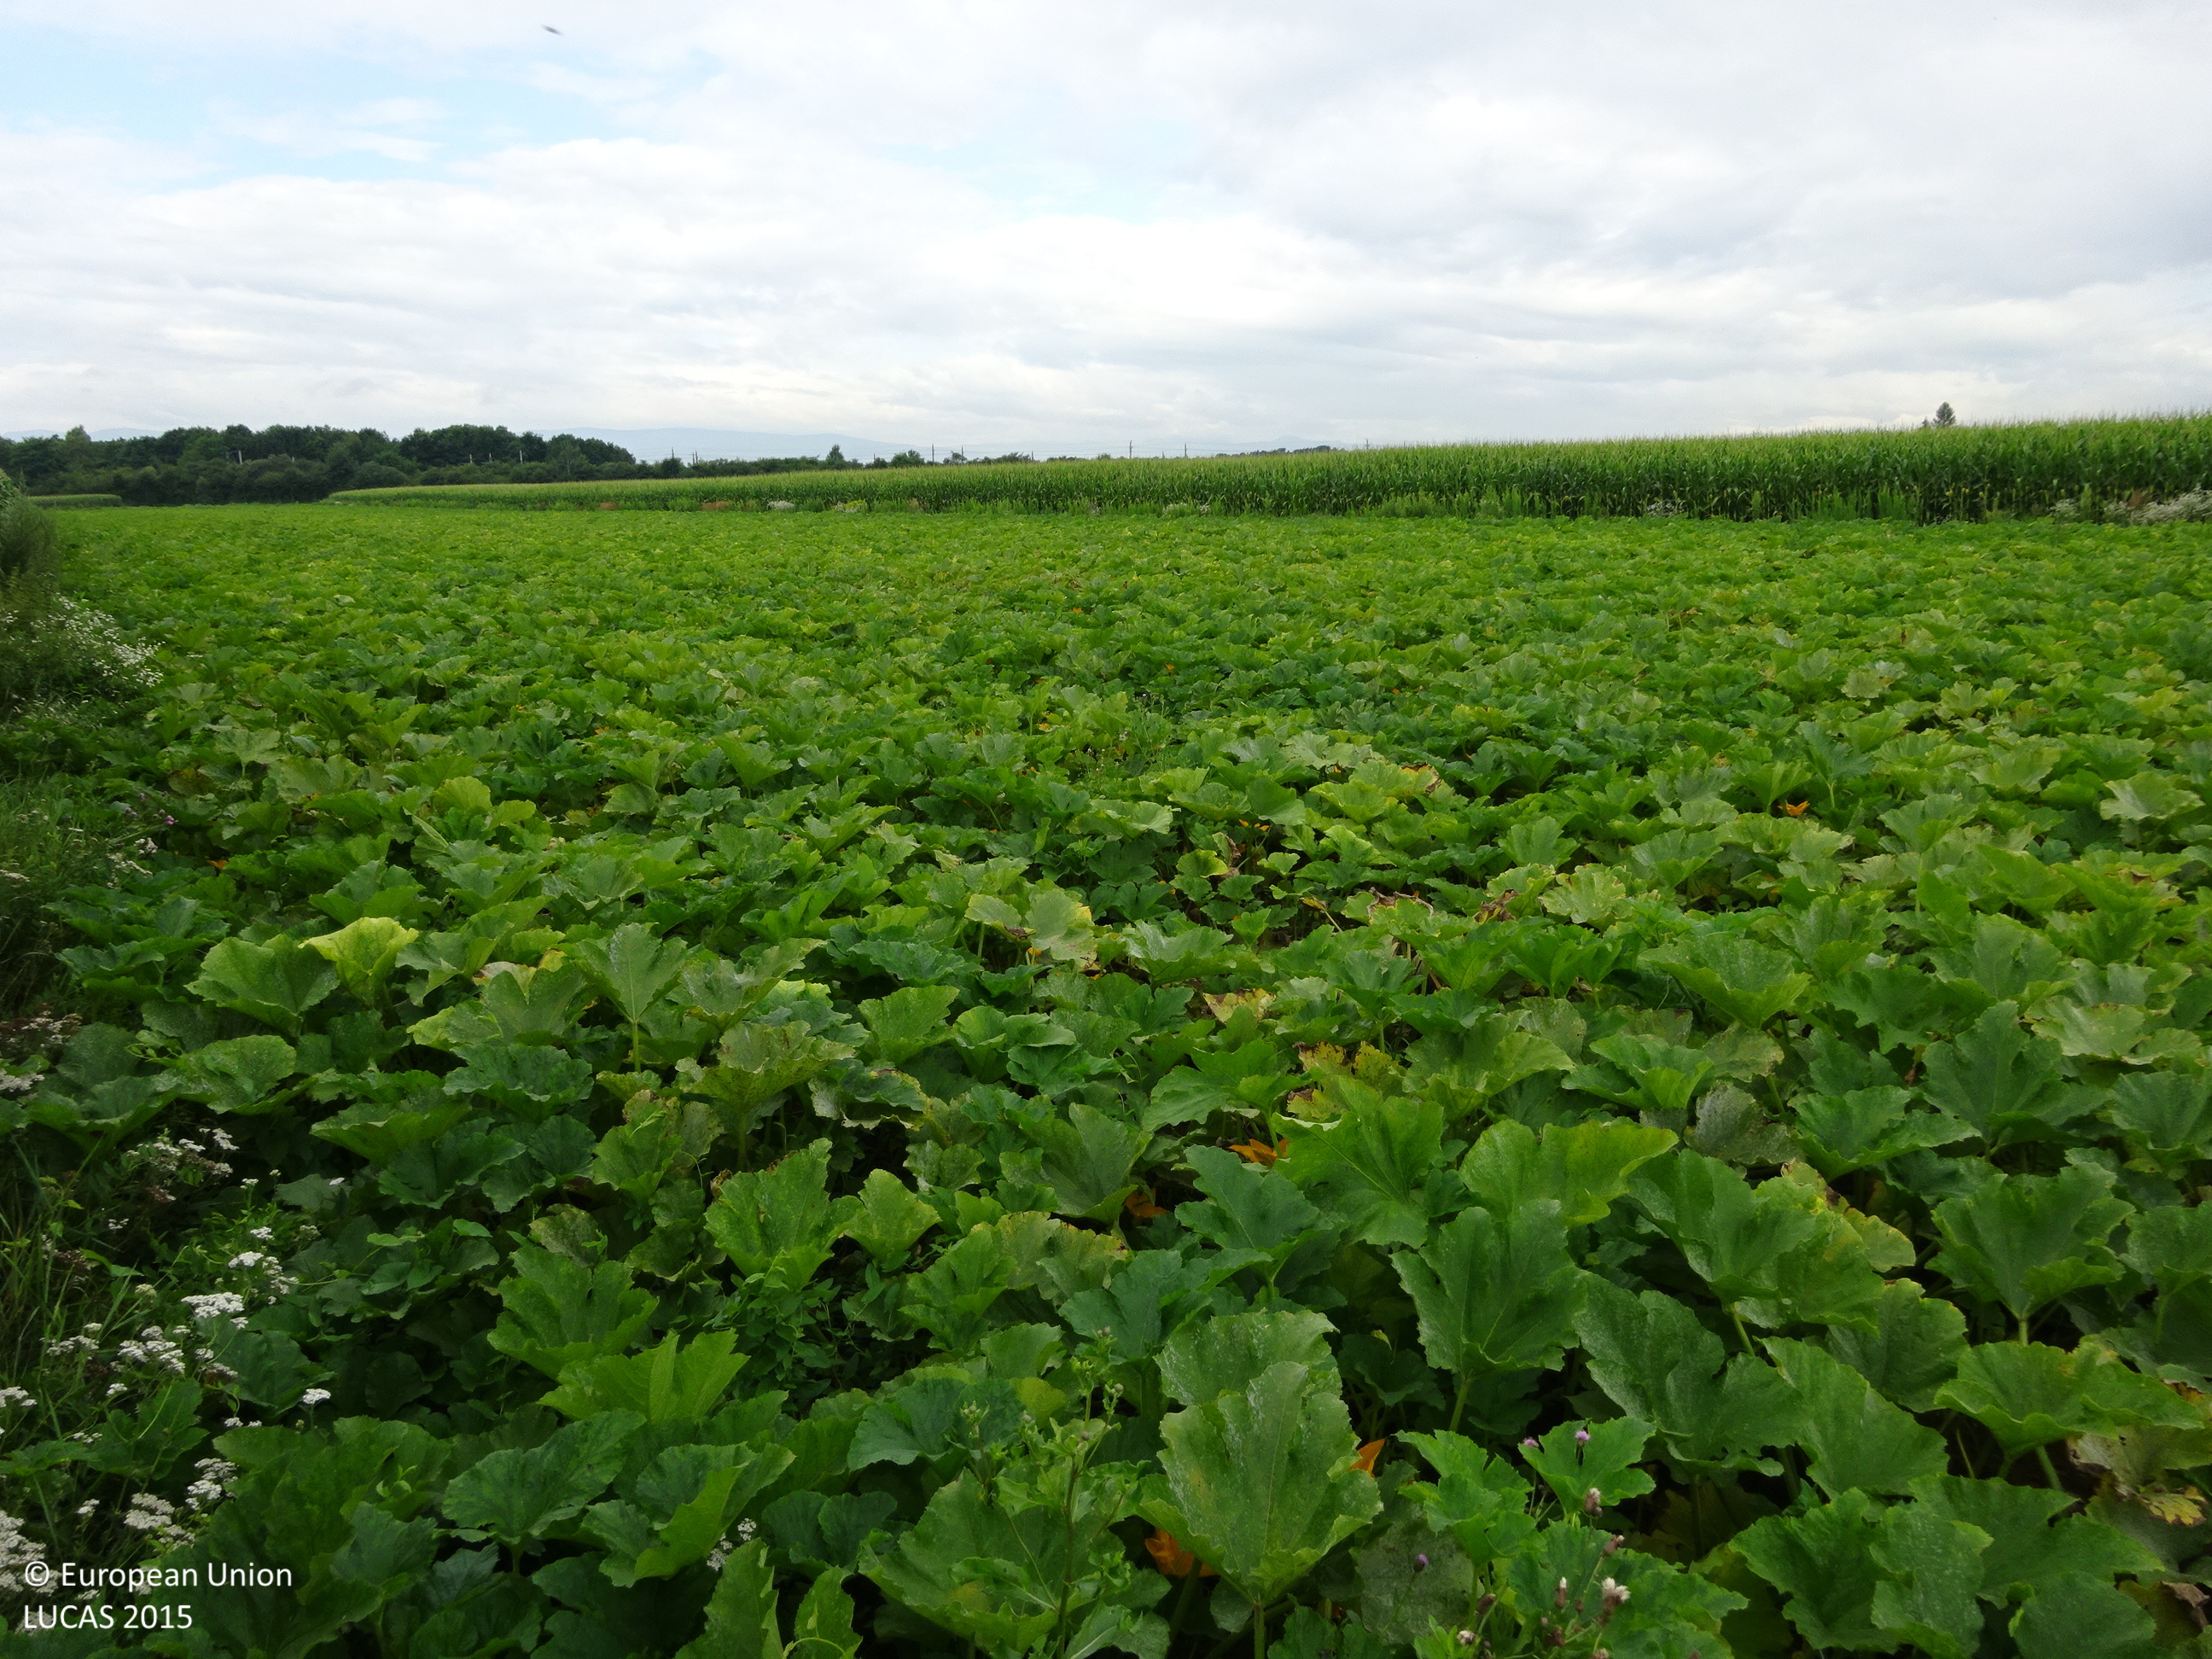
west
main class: Cropland
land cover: Other fibre and oleaginous crops
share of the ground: > 75 %
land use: Agriculture (excluding fallow land and kitchen gardens)
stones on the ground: < 10 %
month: July
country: AT
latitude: 46.9508
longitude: 15.4787
